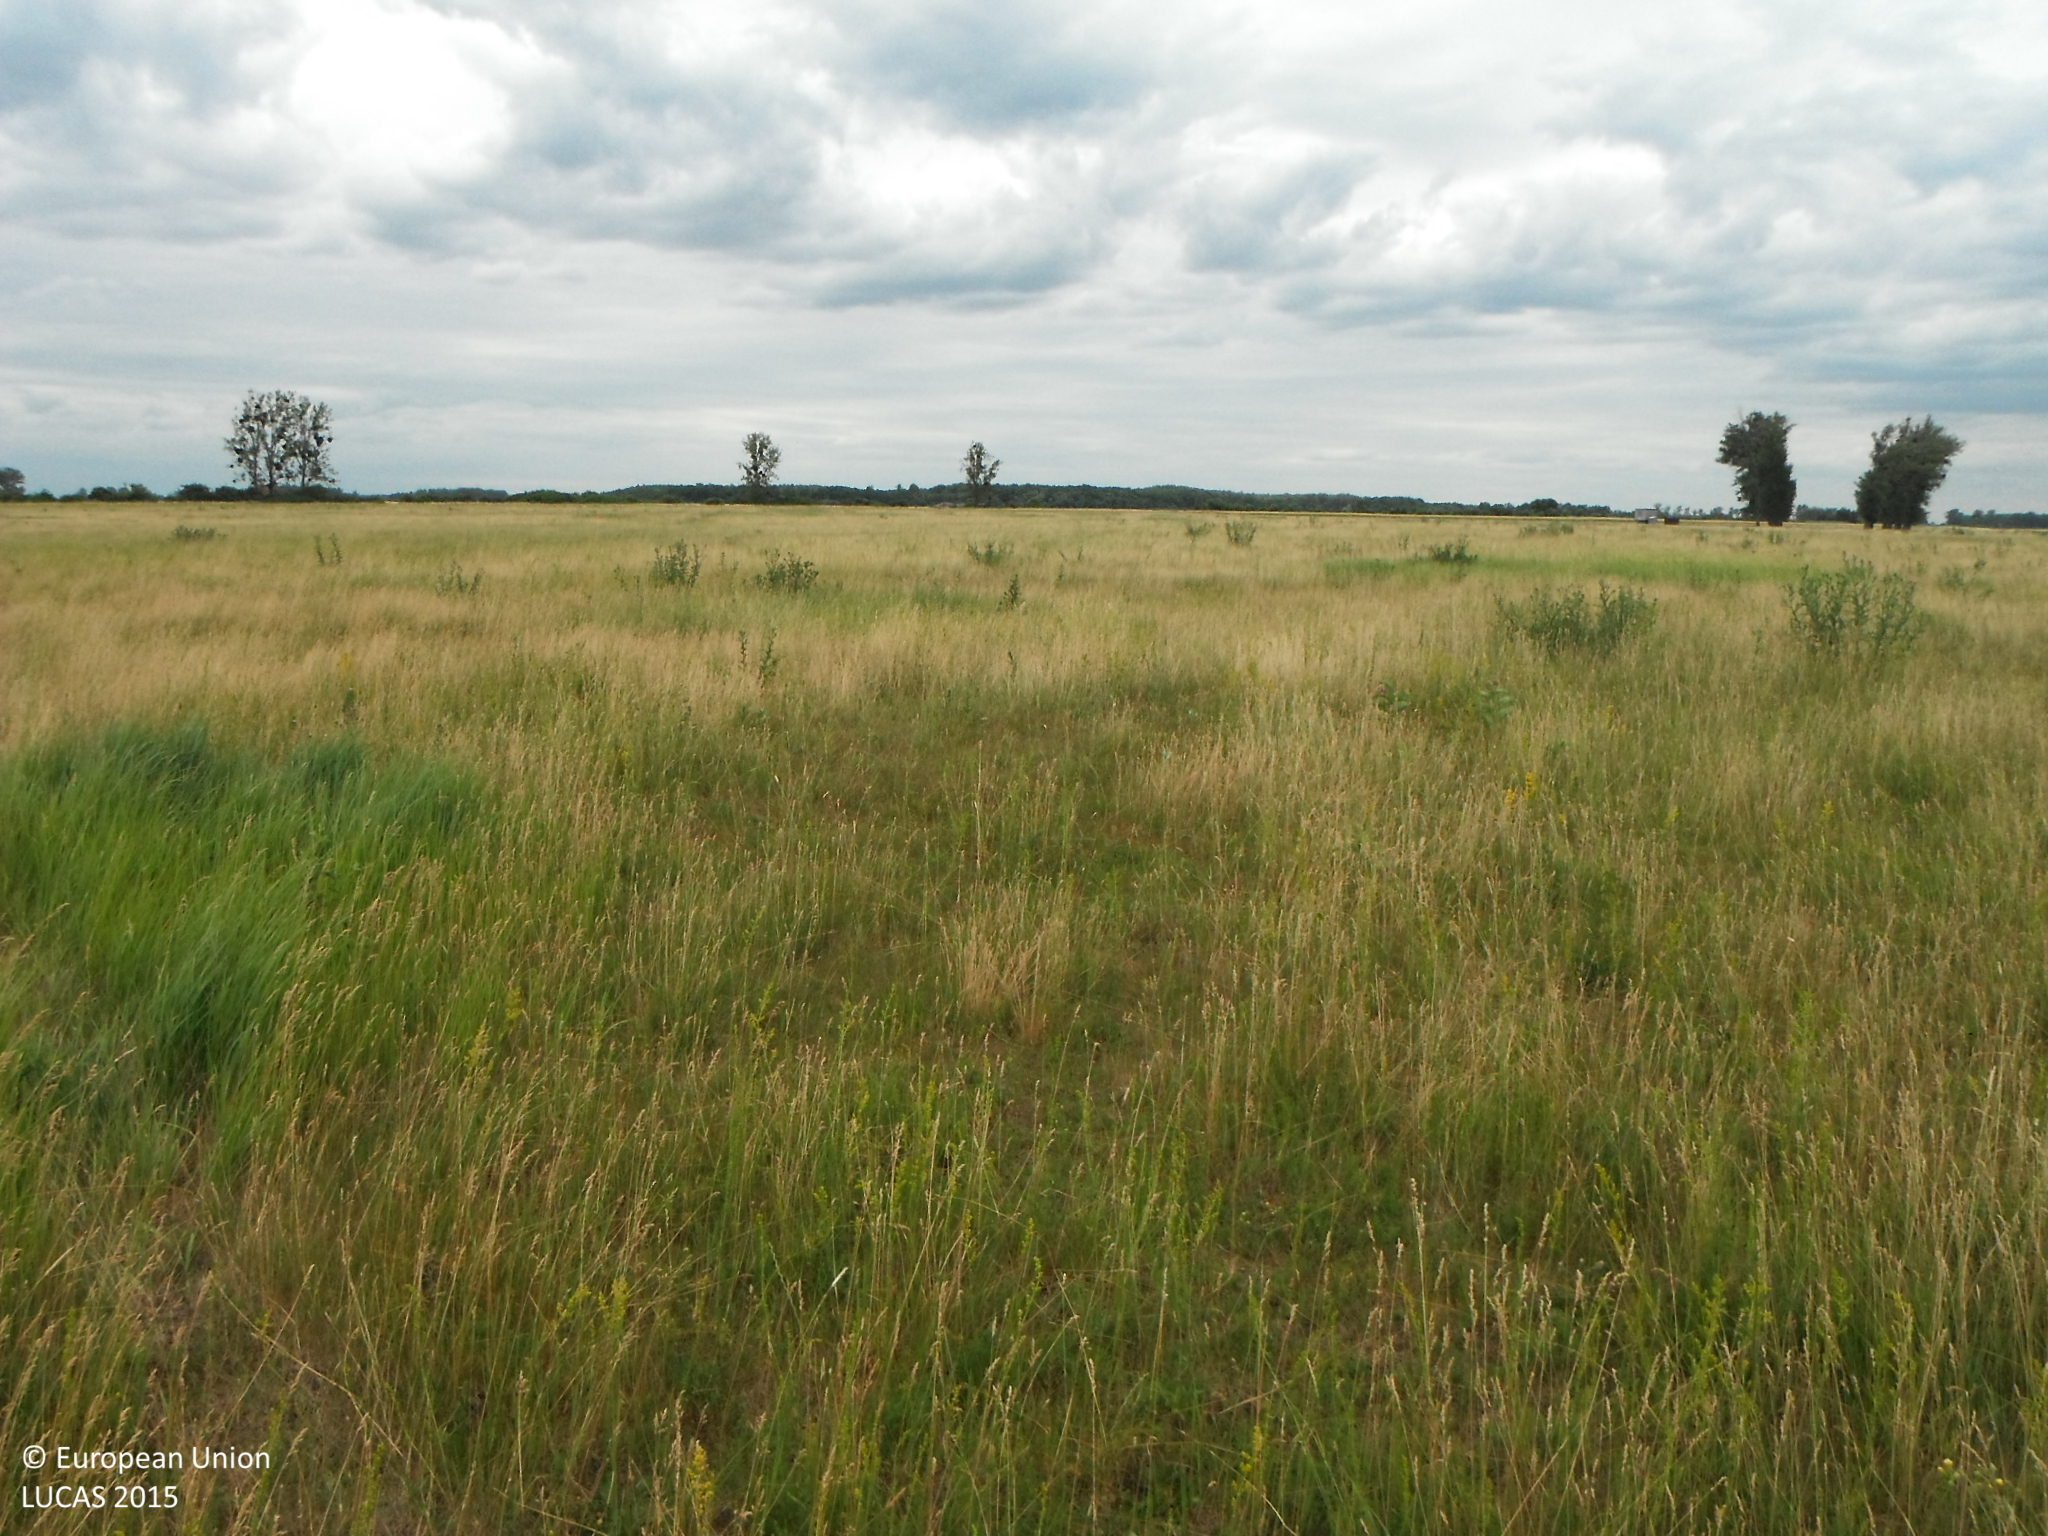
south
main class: Grassland
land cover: Grassland without tree/shrub cover
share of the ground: > 75 %
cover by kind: herbaceous plants 100 %
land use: Agriculture (excluding fallow land and kitchen gardens)
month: June
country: SK
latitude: 48.3534
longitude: 21.7773
